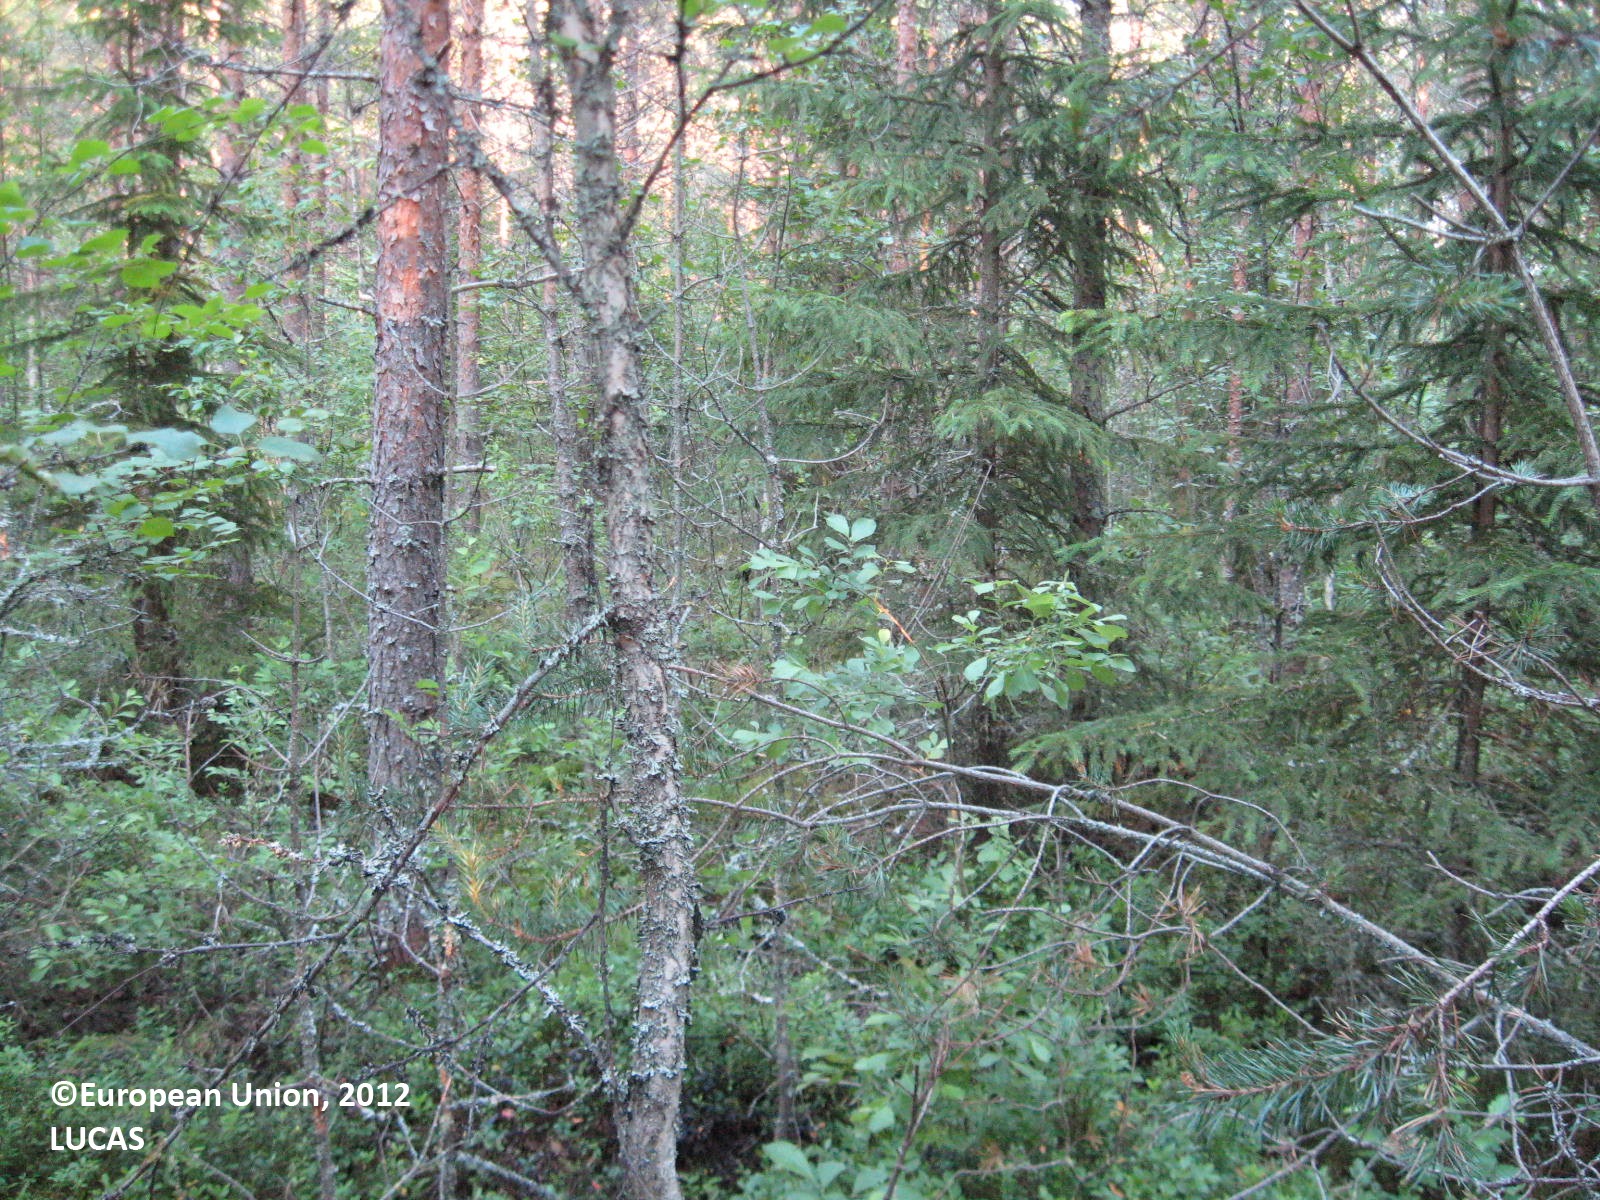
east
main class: Woodland
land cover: Pine dominated mixed woodland
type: boreal forest
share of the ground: > 75 %
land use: Forestry
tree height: > 5 m
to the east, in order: Pine dominated mixed woodland; Ditches and canals; Pine dominated coniferous woodland; Ditches and canals; Pine dominated mixed woodland; Ditches and canals; Pine dominated coniferous woodland; Ditches and canals; Pine dominated coniferous woodland; Ditches and canals; Pine dominated coniferous woodland
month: July
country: FI
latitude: 62.4179
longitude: 21.6027
